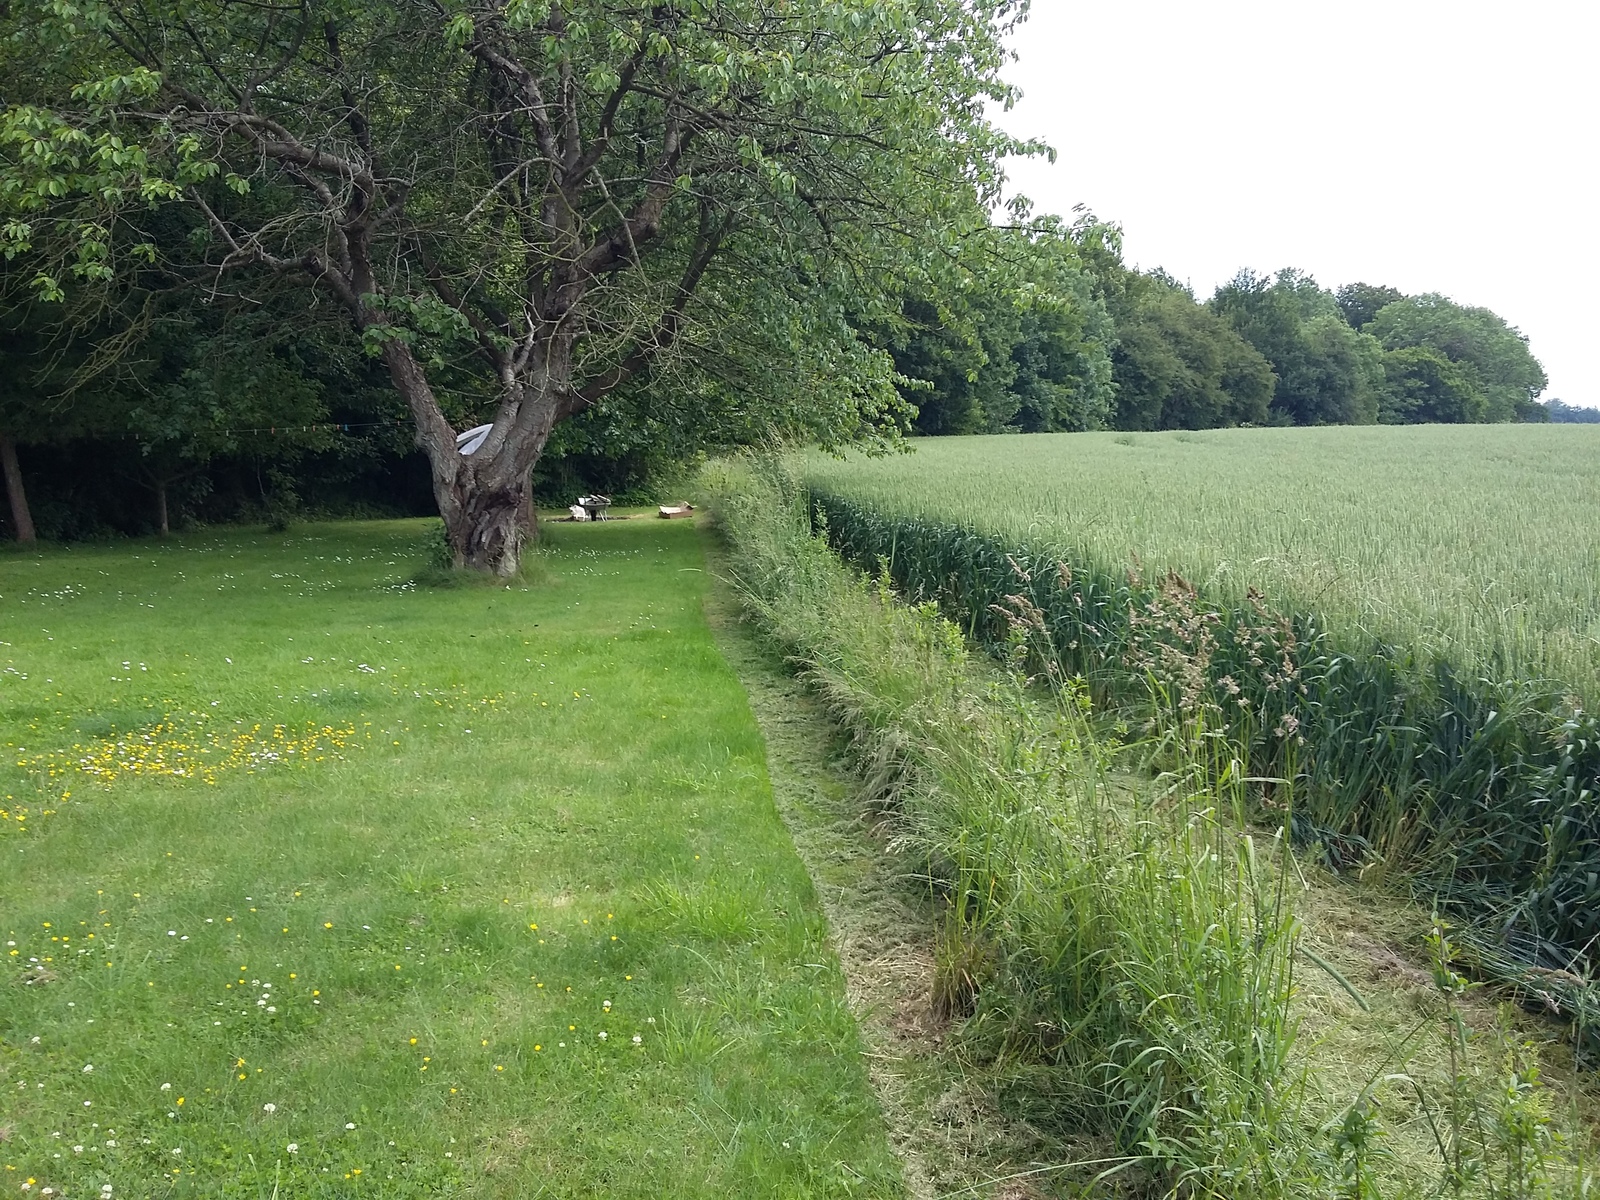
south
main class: Grassland
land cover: Grassland with sparse tree/shrub cover
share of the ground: > 75 %
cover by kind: herbaceous plants 95 %, broadleaved forest trees 5 %
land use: Residential
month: June
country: DK
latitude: 54.8395
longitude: 12.1319
